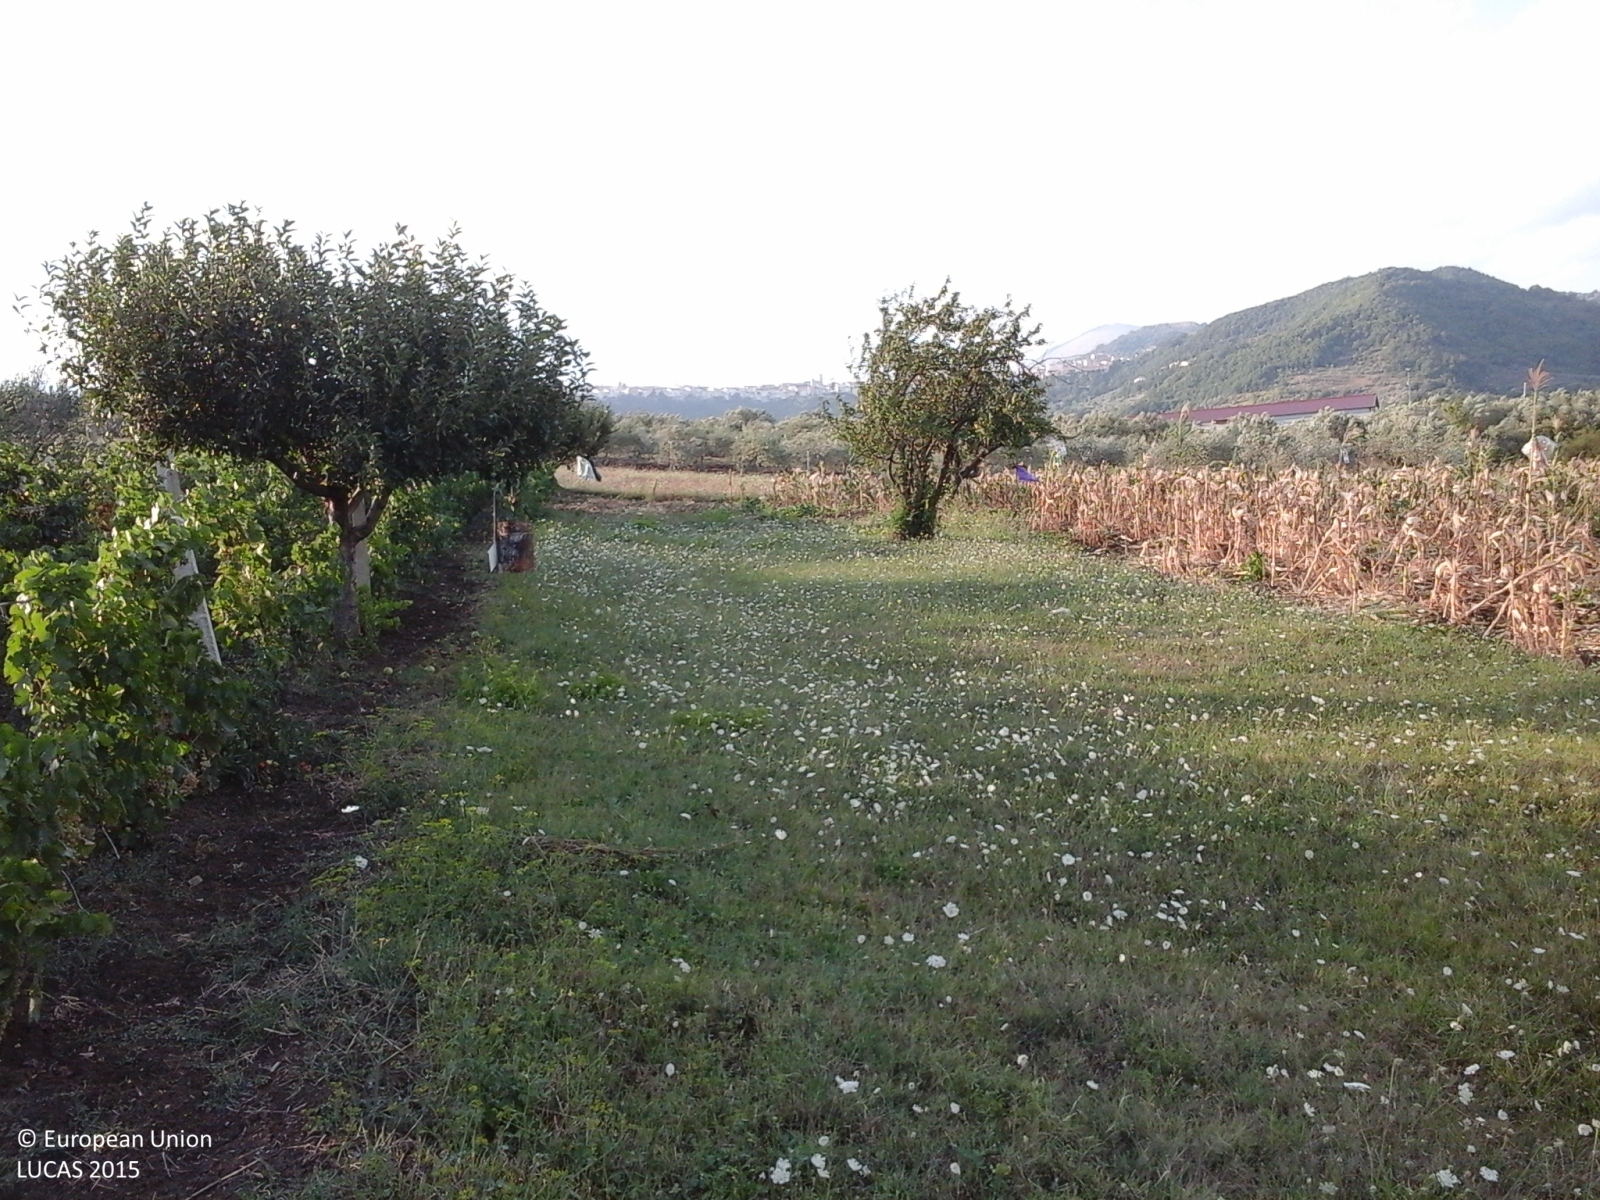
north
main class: Cropland
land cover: Temporary grasslands
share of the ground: > 75 %
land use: Agriculture (excluding fallow land and kitchen gardens)
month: August
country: IT
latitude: 41.7815
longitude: 14.3767
